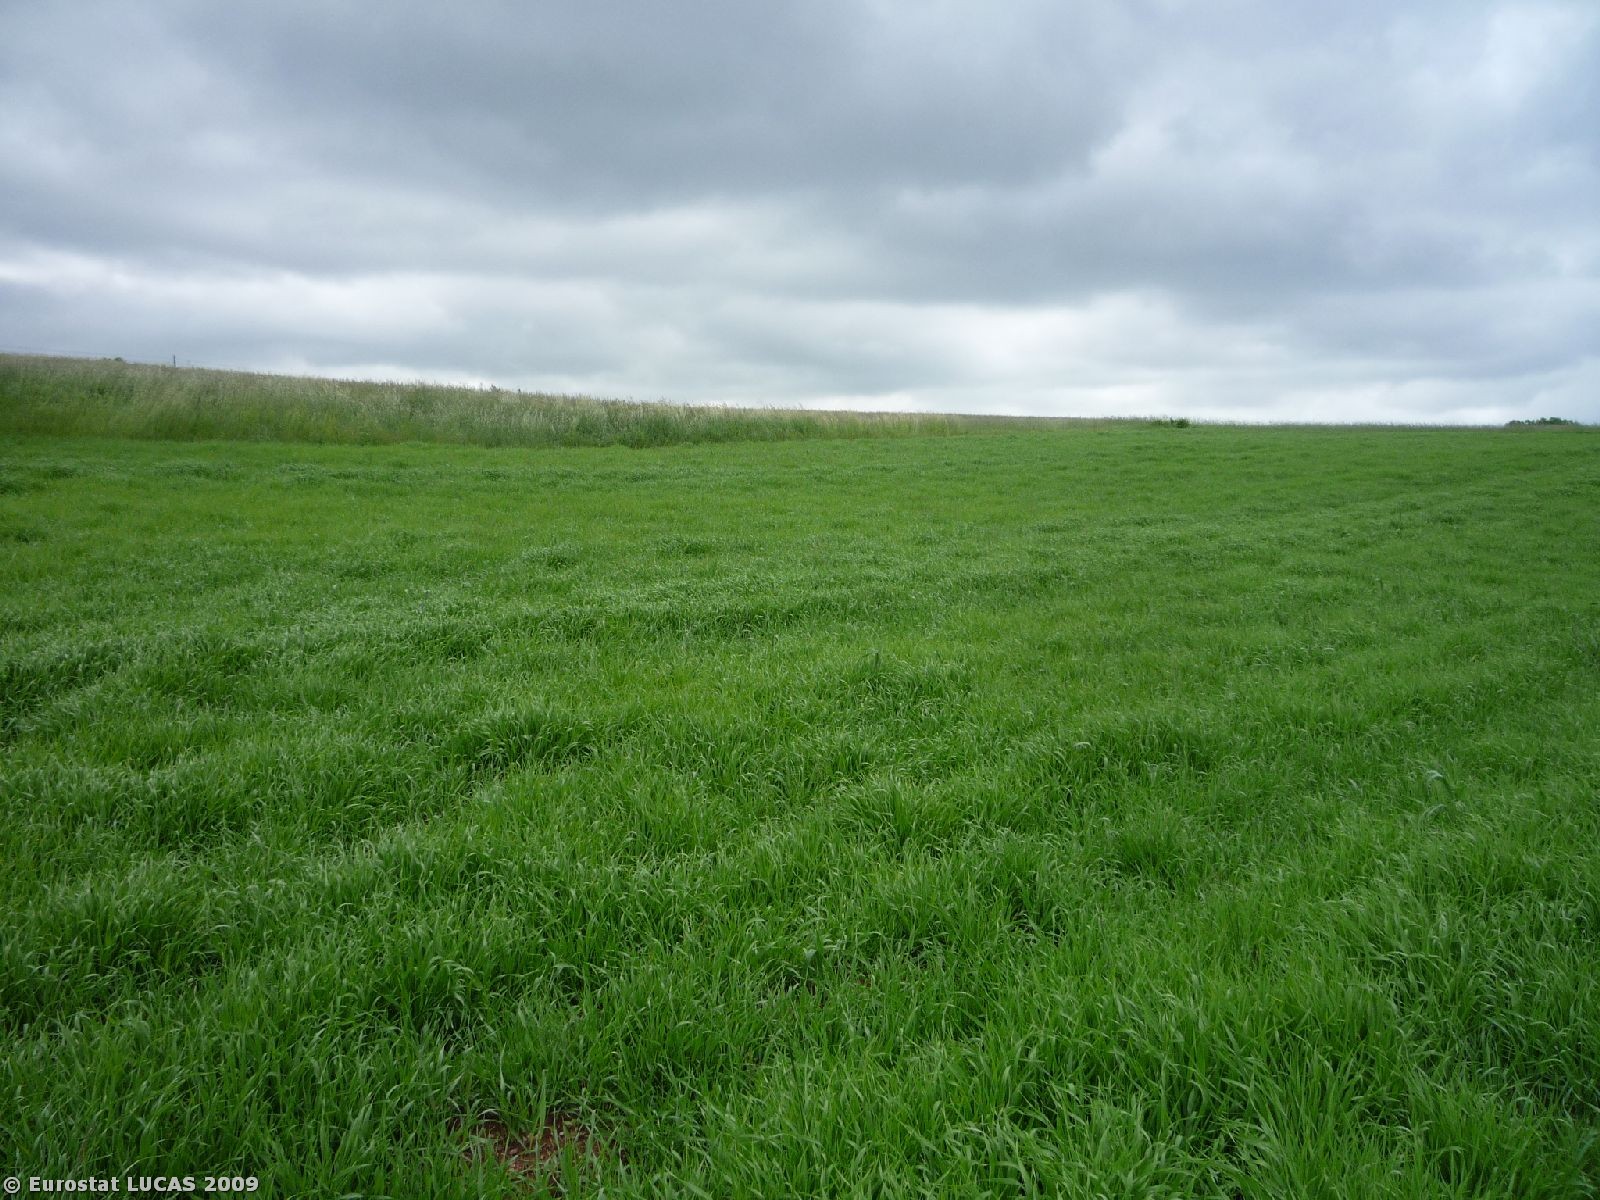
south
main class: Cropland
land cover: Barley
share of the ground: > 75 %
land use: Agriculture (excluding fallow land and kitchen gardens)
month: June
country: CZ
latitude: 50.5013
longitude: 15.5168
